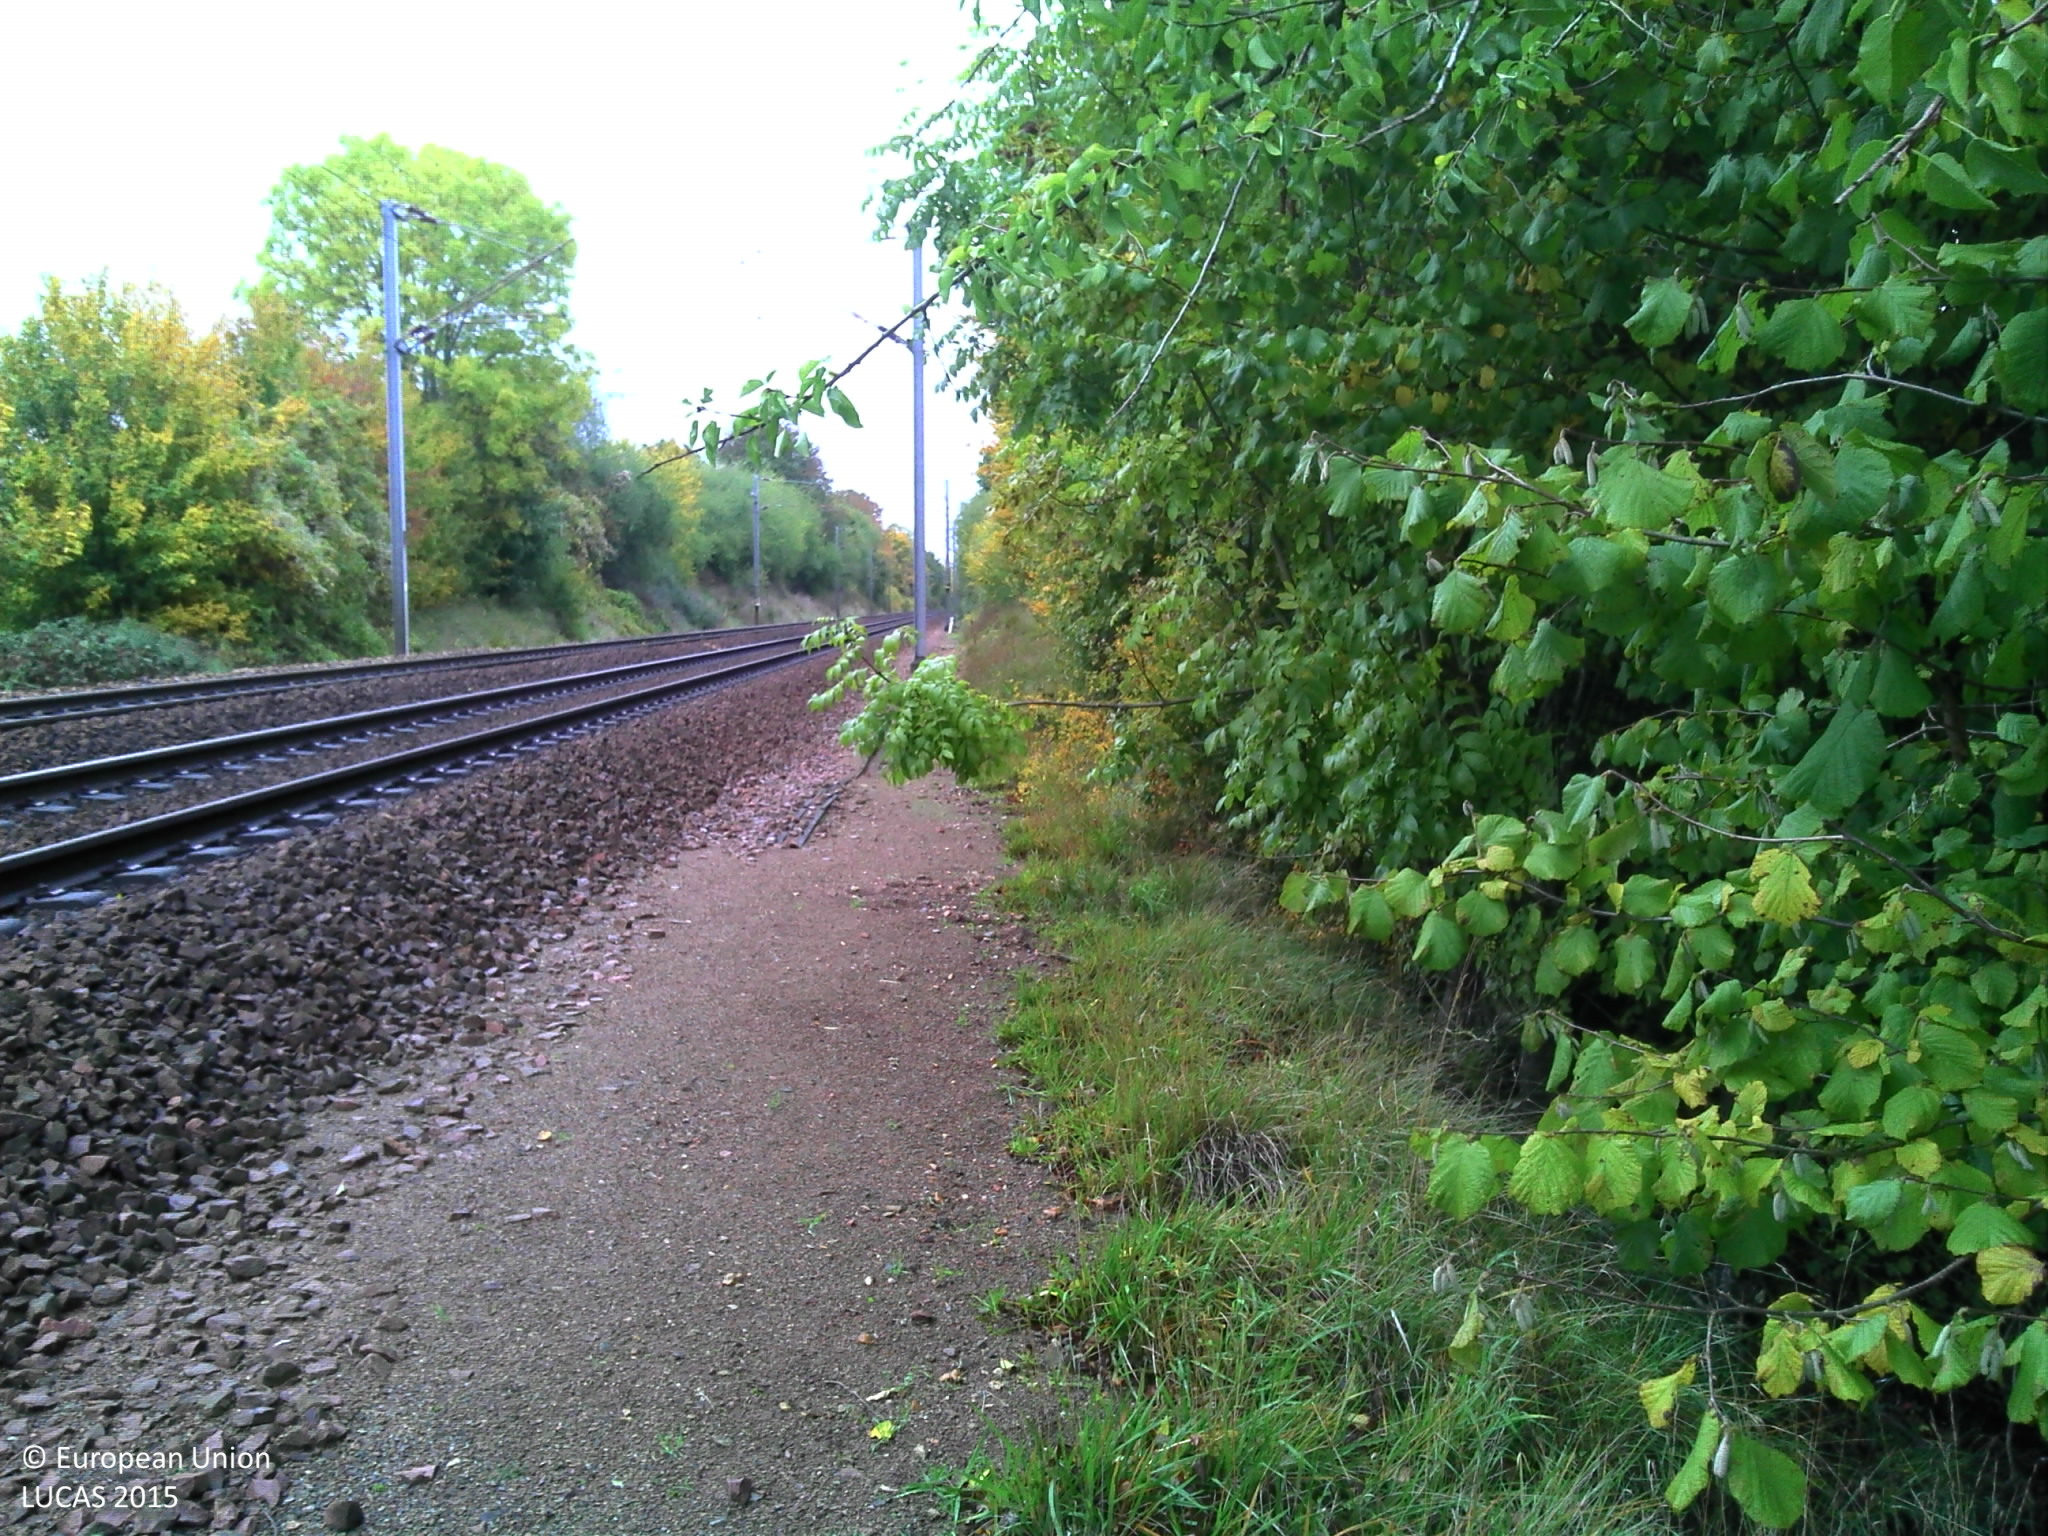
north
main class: Cropland
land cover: Other fibre and oleaginous crops
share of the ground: 50 - 75 %
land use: Agriculture (excluding fallow land and kitchen gardens)
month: October
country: FR
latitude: 48.8278
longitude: 1.8801
